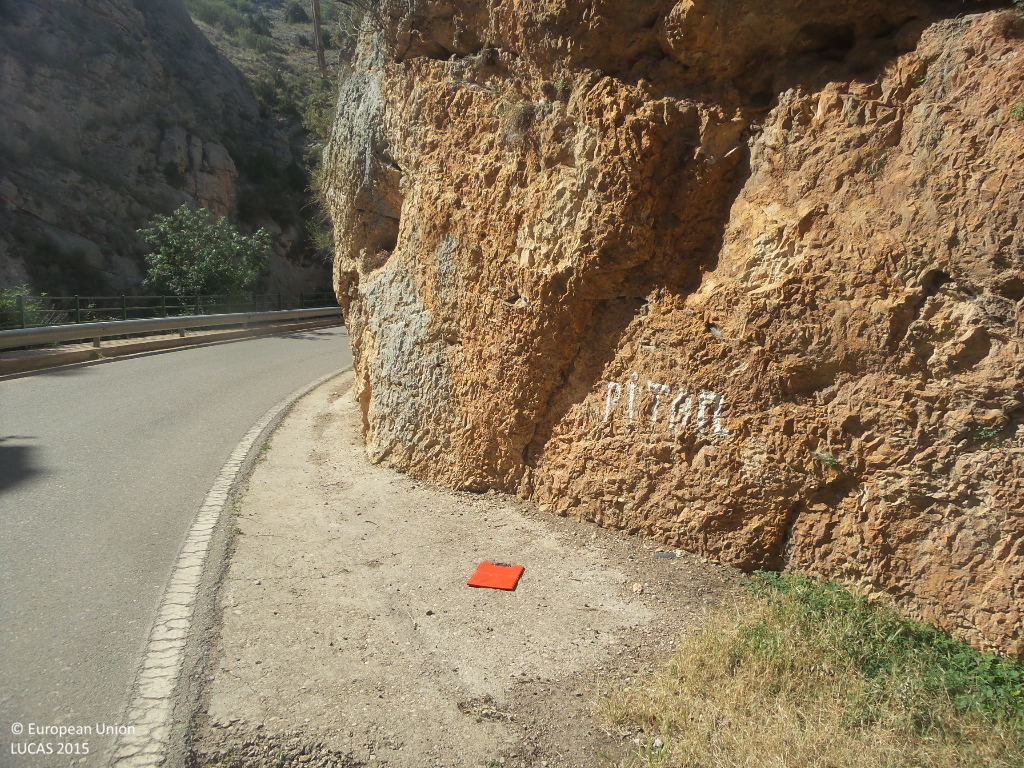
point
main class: Shrubland
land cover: Shrubland without tree cover
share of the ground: 10 - 25 %
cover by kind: unconsolidated bare surface 60 %, shrubs 20 %, herbaceous plants 20 %
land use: Semi-natural and natural areas not in use
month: July
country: ES
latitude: 41.1851
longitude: -1.8881
